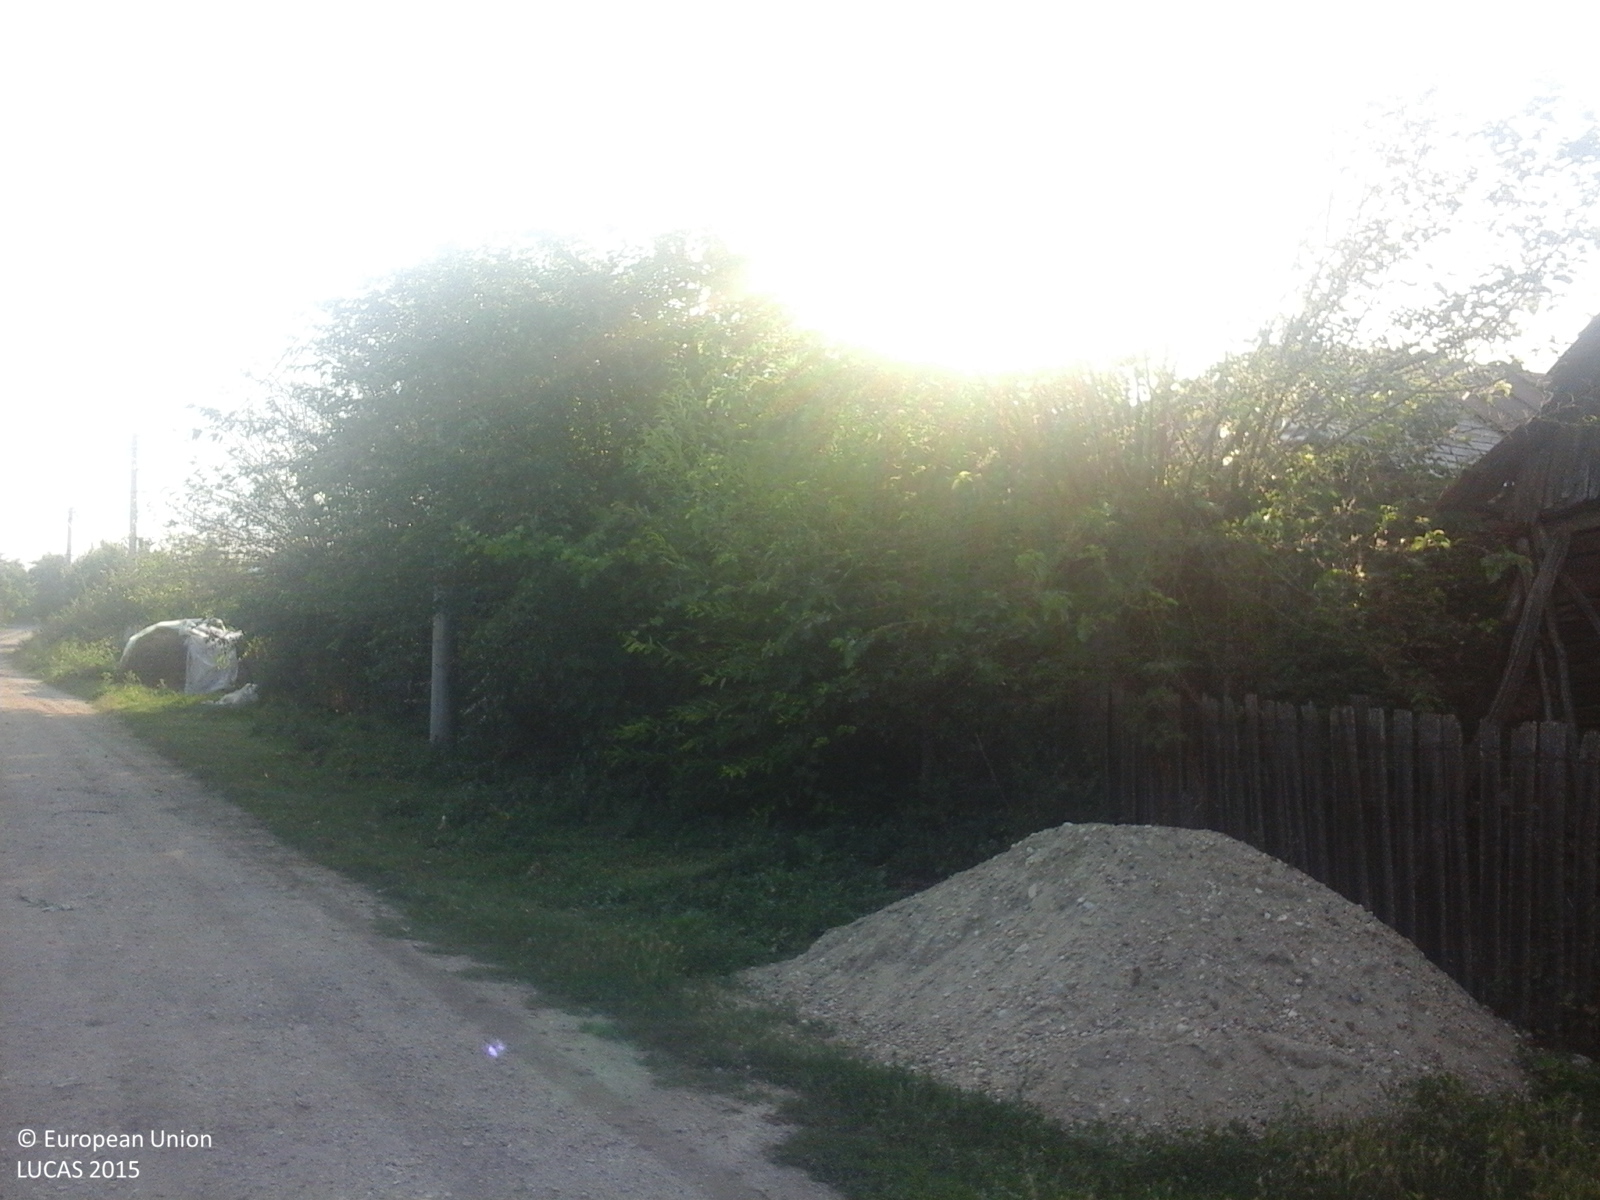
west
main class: Cropland
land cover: Other fresh vegetables
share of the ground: > 75 %
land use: Kitchen garden
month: July
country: RO
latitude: 43.9541
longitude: 25.9344
